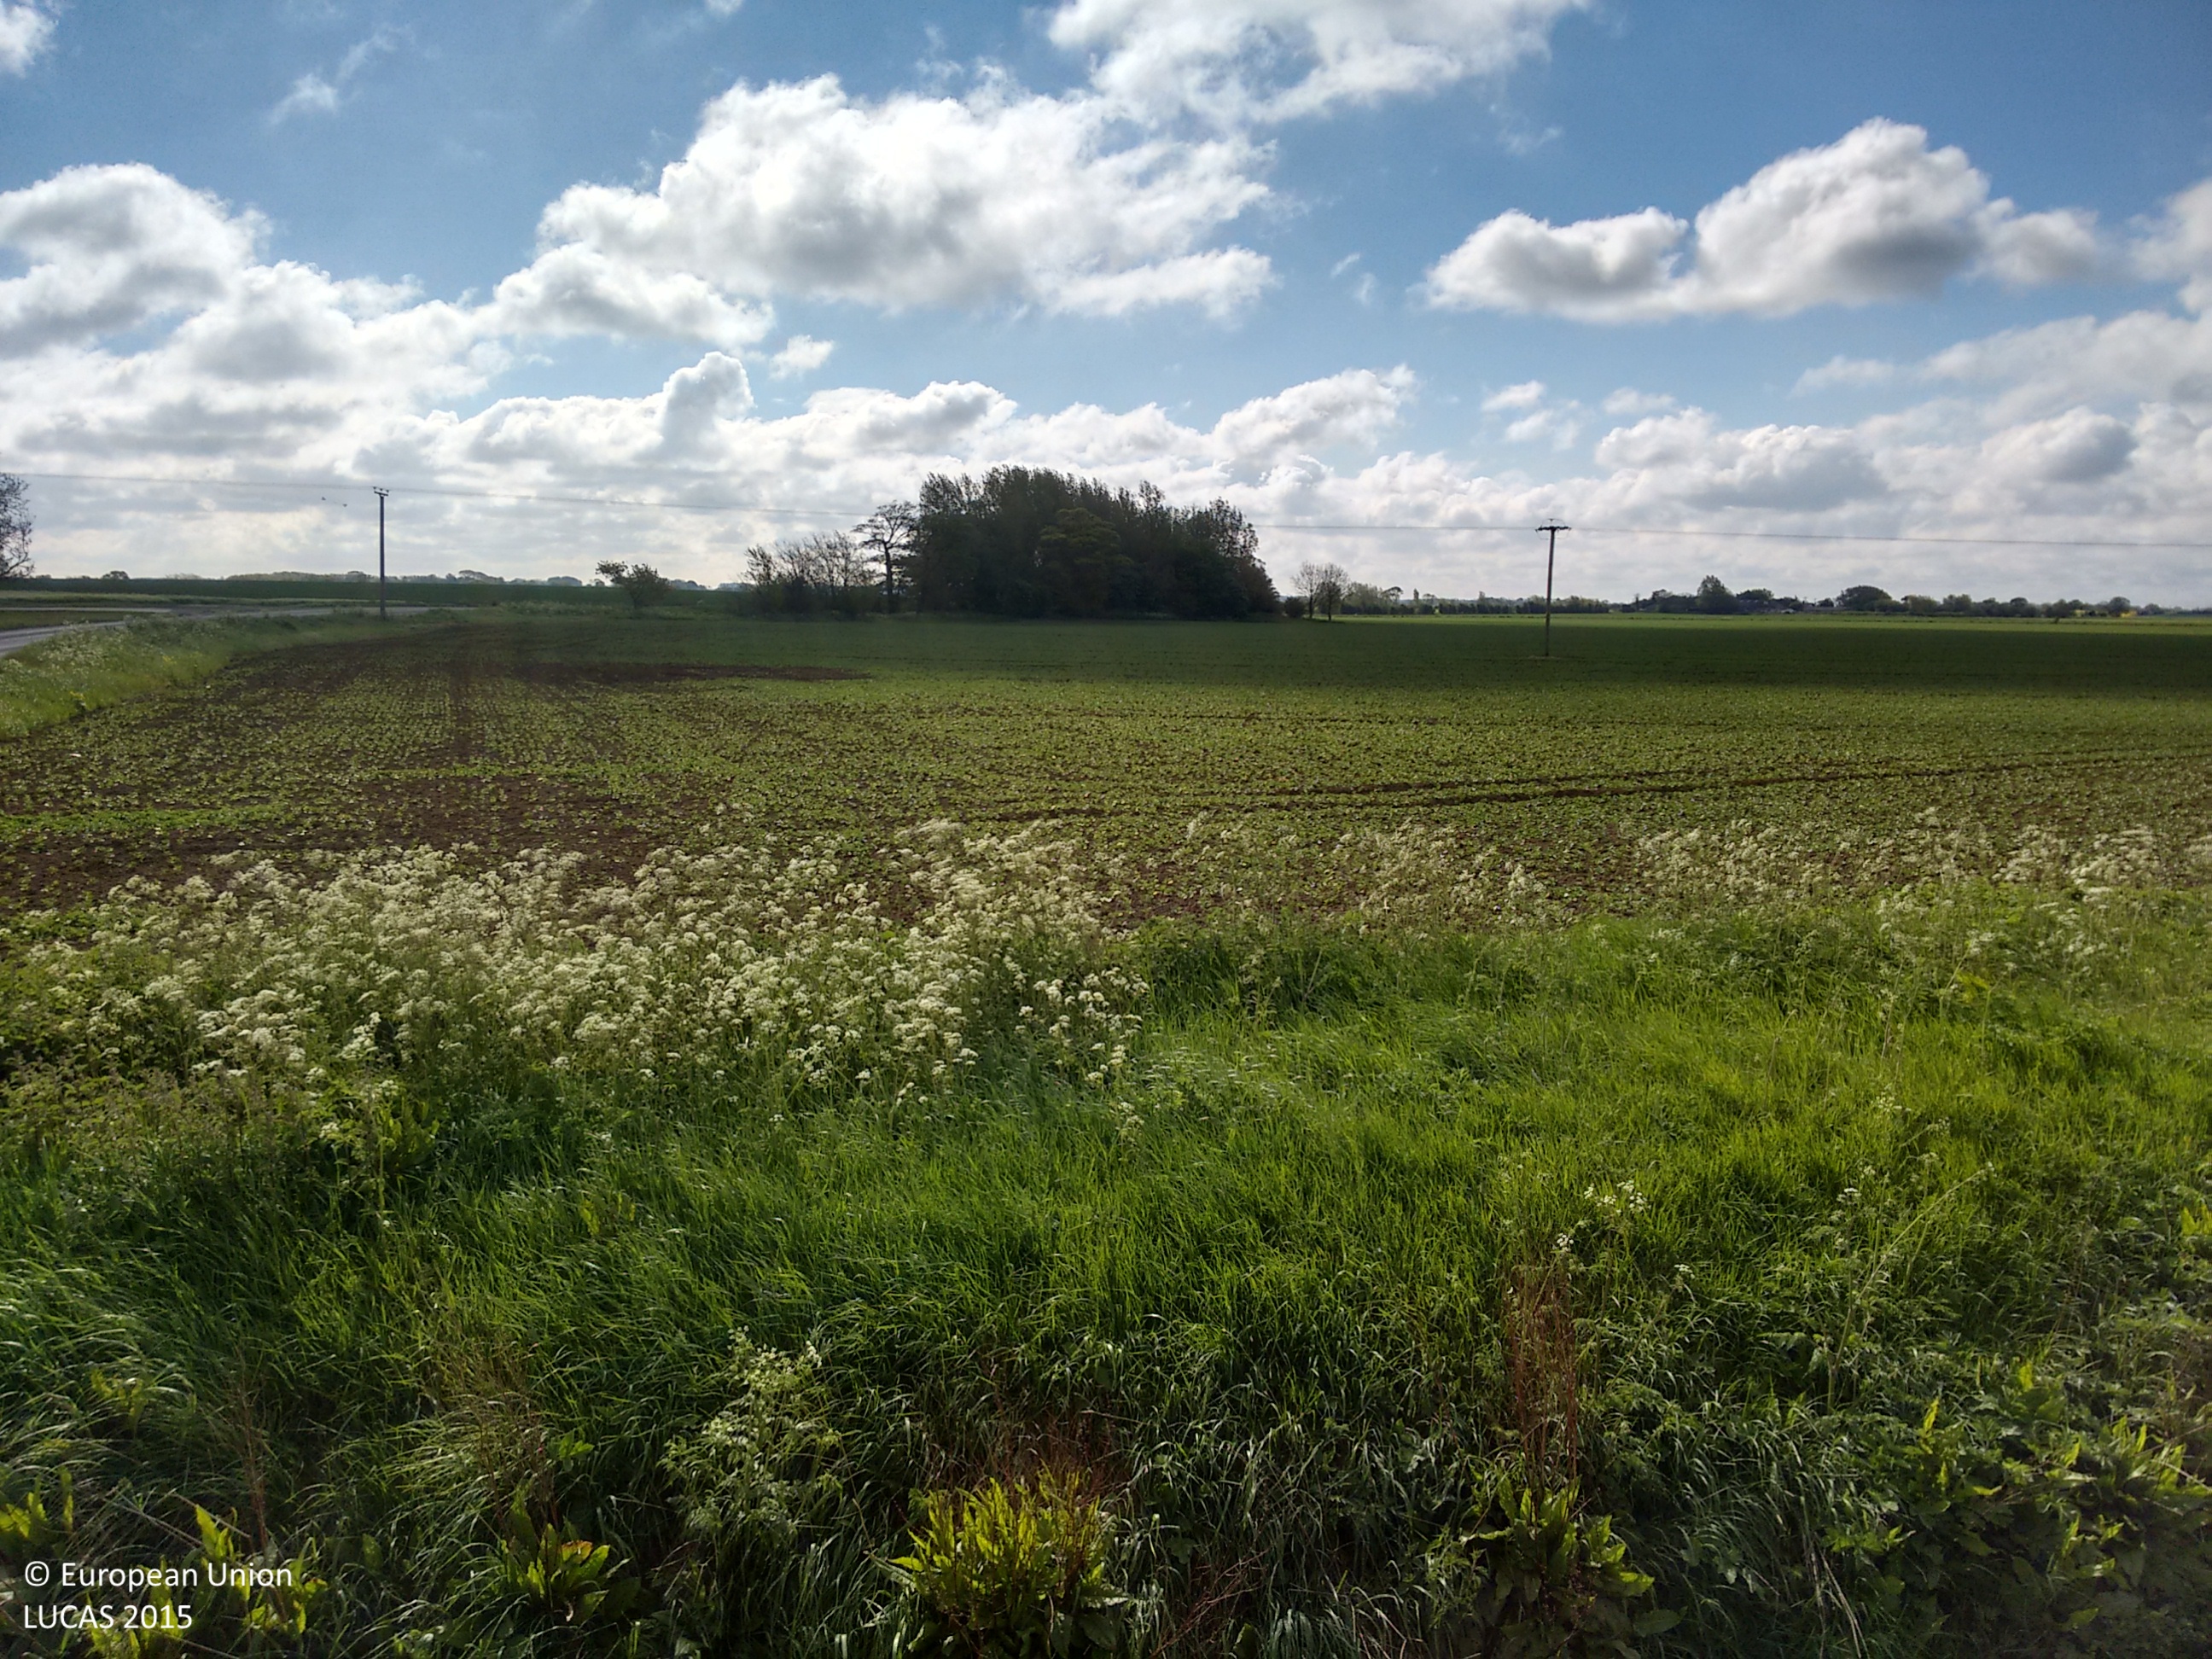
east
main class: Cropland
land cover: Common wheat
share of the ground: > 75 %
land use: Agriculture (excluding fallow land and kitchen gardens)
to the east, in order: Grass margins; Dry pulses; Grass margins; Paved roads, cycling and walking lanes; Grassland without tree/shrub cover; Ditches and canals; Managed hedges; Grassland without tree/shrub cover; Paved roads, cycling and walking lanes; Grass margins; Electric lines; Abandoned hedges; Grass margins; Oats; Common wheat
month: May
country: GB
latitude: 53.7386
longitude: -0.1145
